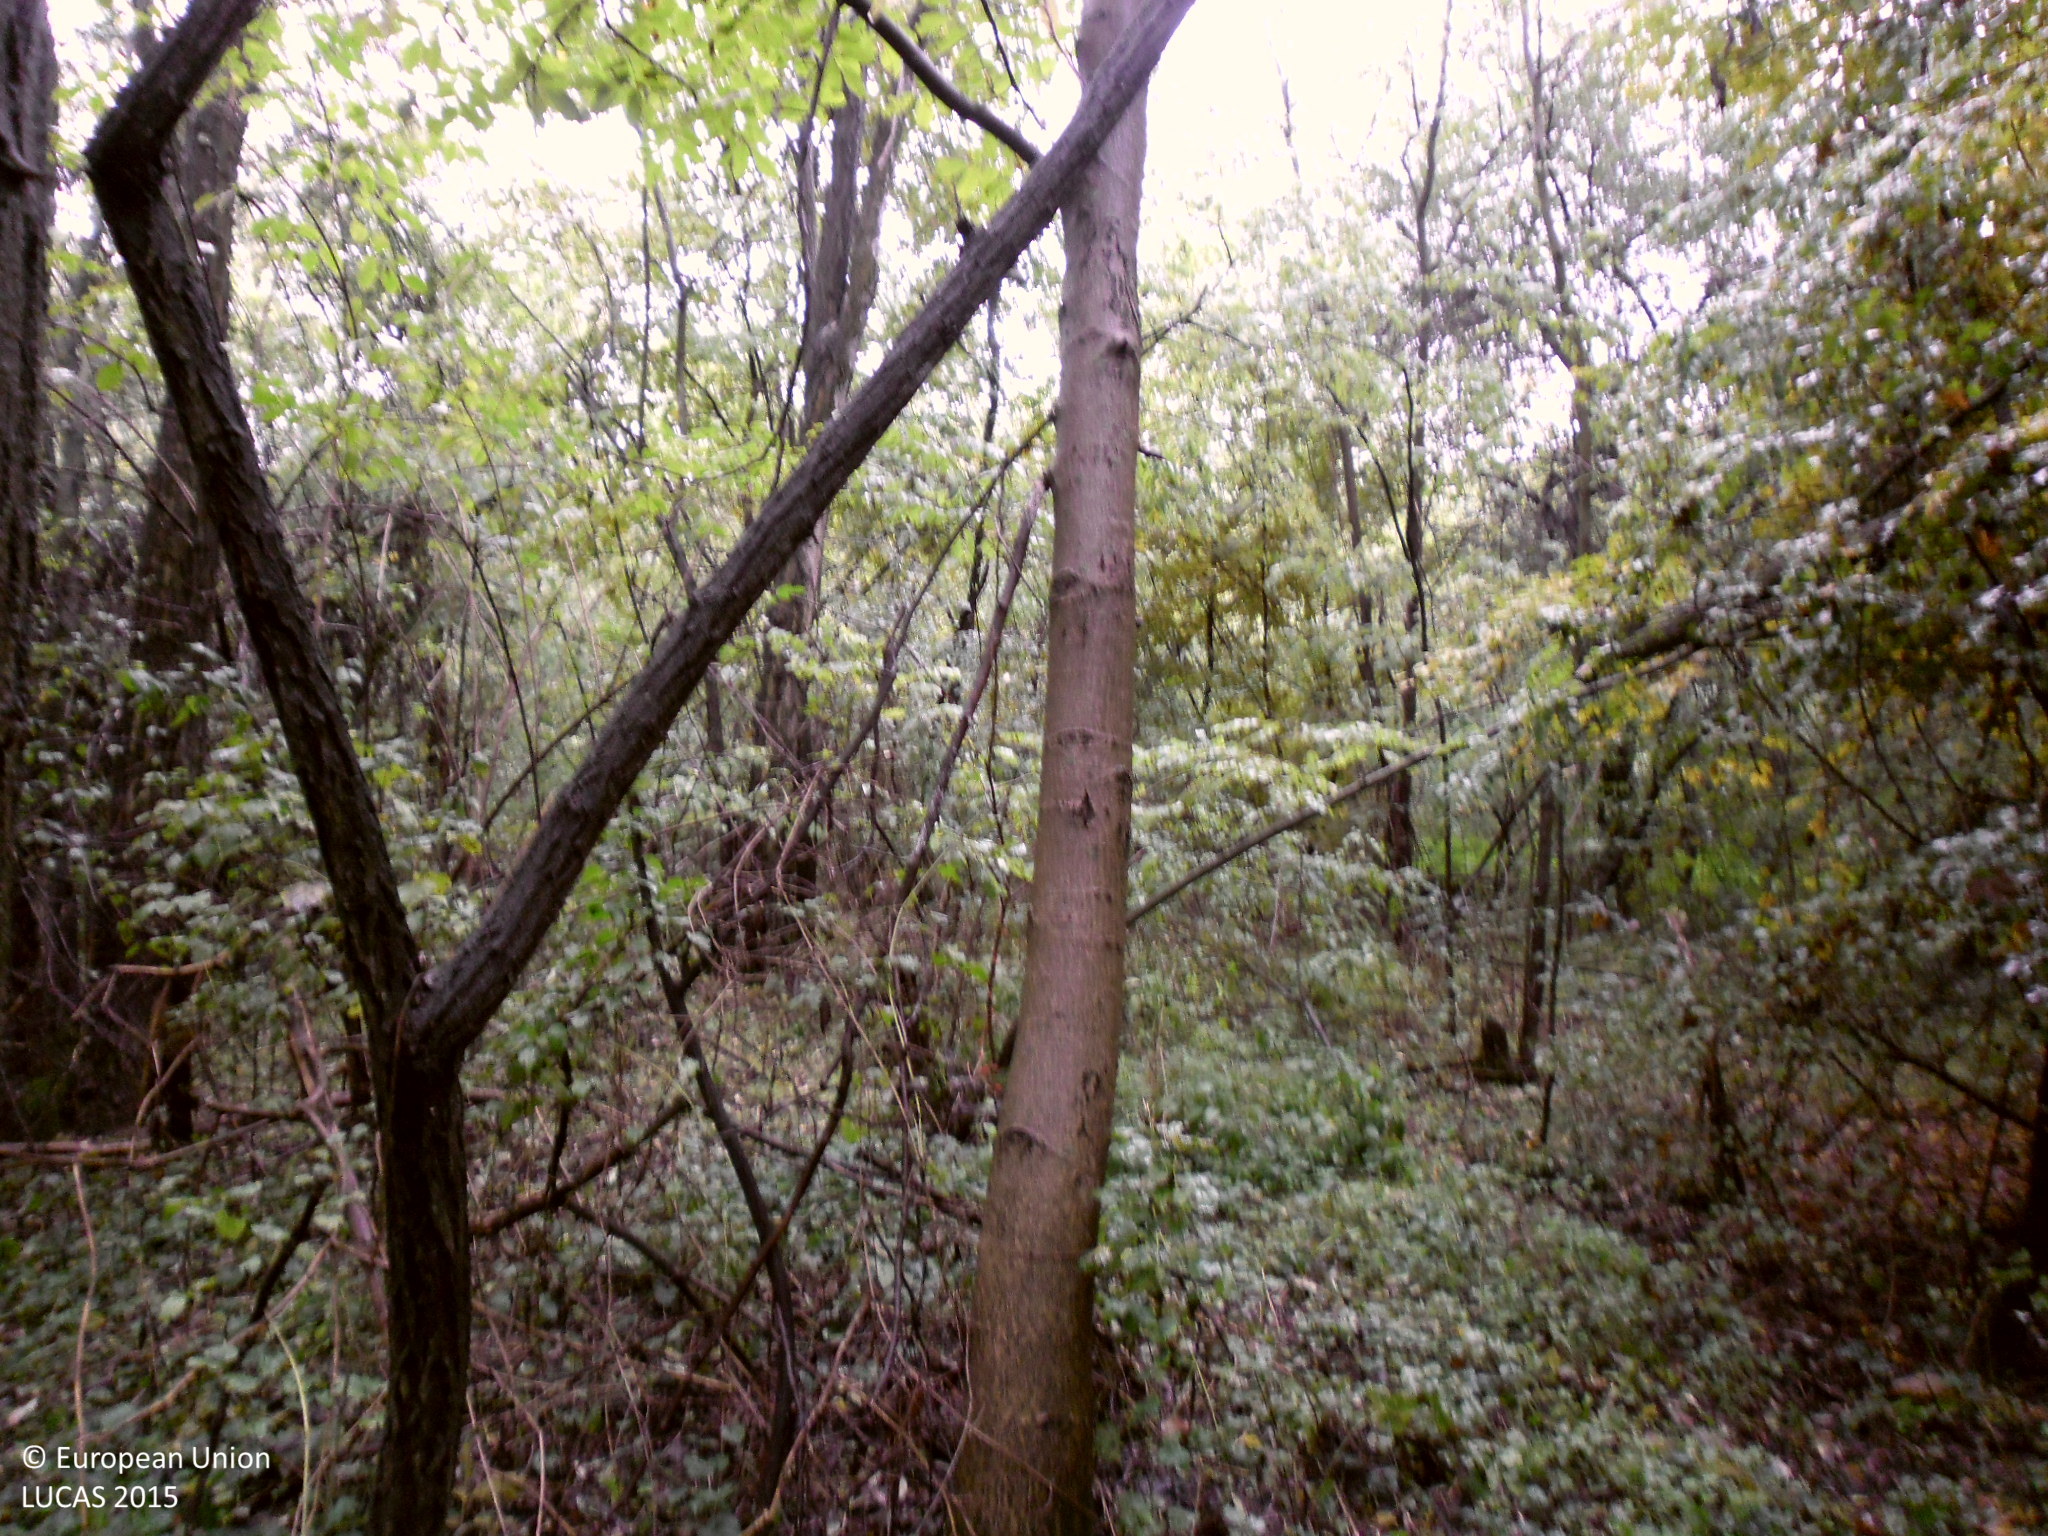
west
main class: Woodland
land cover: Broadleaved woodland
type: mesophytic deciduous forest
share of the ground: > 75 %
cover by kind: broadleaved forest trees 100 %
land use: Forestry
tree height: > 5 m
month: October
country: BG
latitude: 43.9166
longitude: 22.5249
